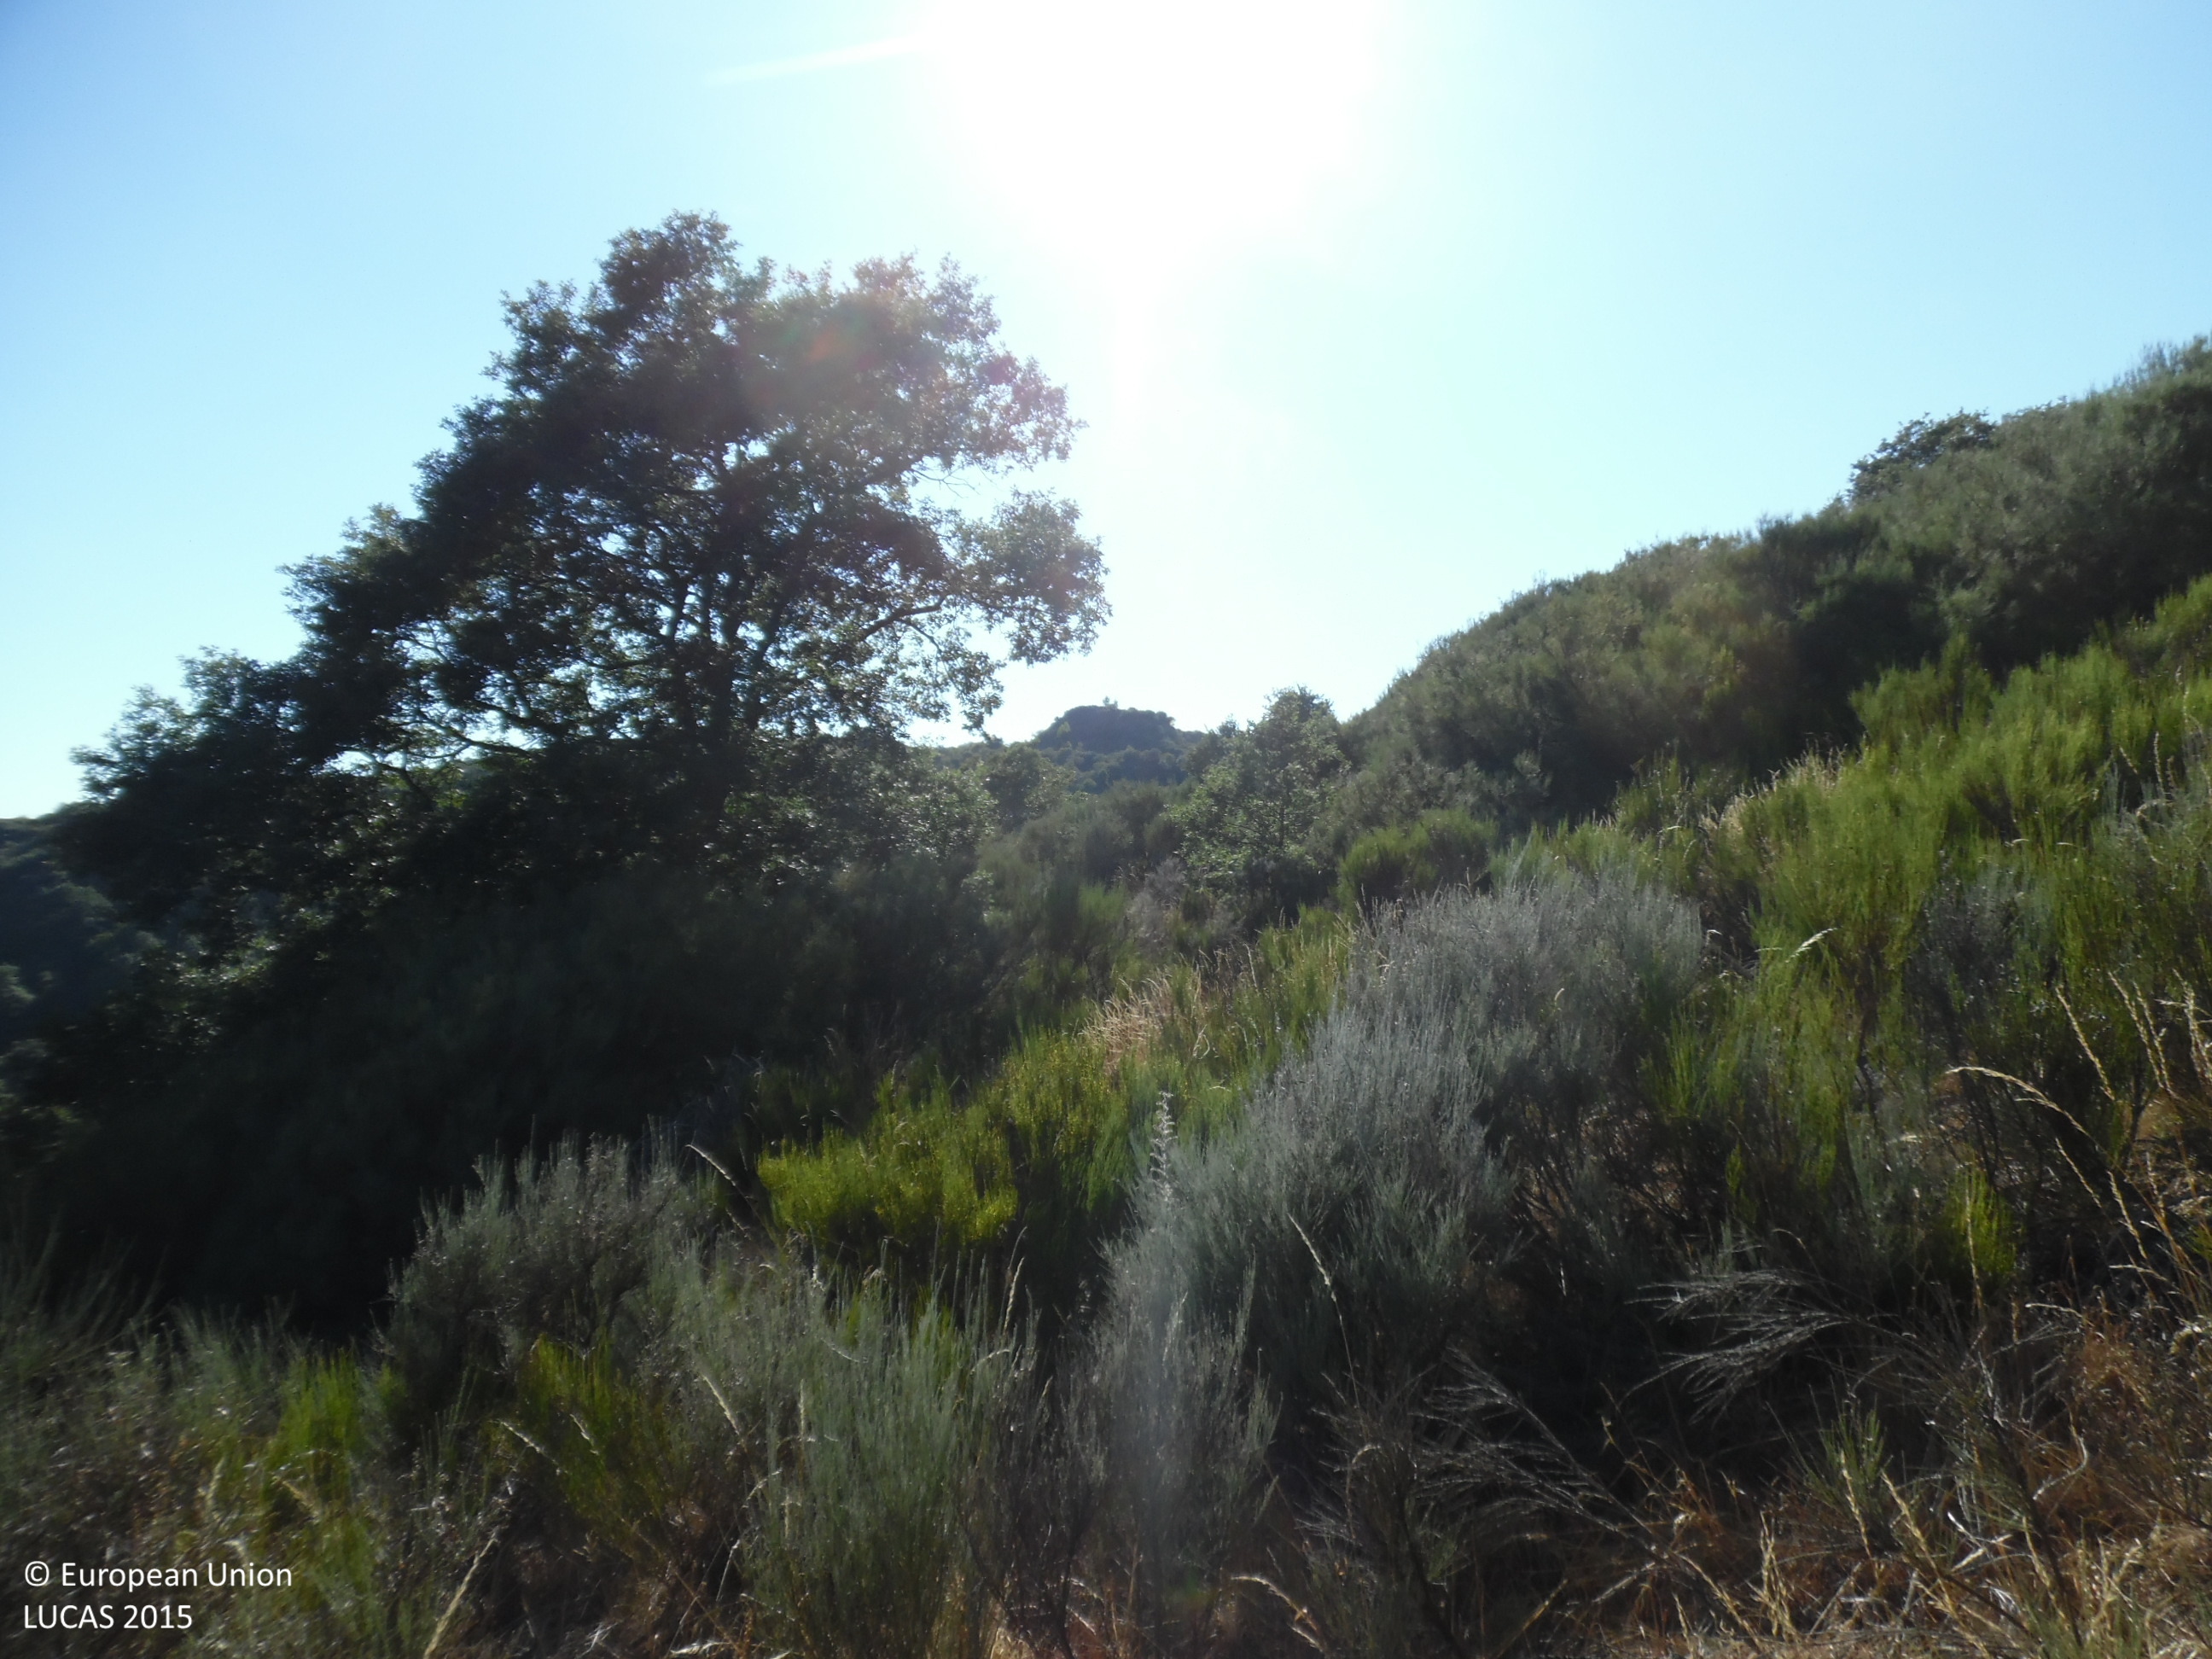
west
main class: Shrubland
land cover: Shrubland with sparse tree cover
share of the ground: > 75 %
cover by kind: shrubs 95 %, broadleaved forest trees 5 %
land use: Abandoned areas
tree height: > 5 m
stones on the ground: 10 - 25 %
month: August
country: ES
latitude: 42.7367
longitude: -6.1995
